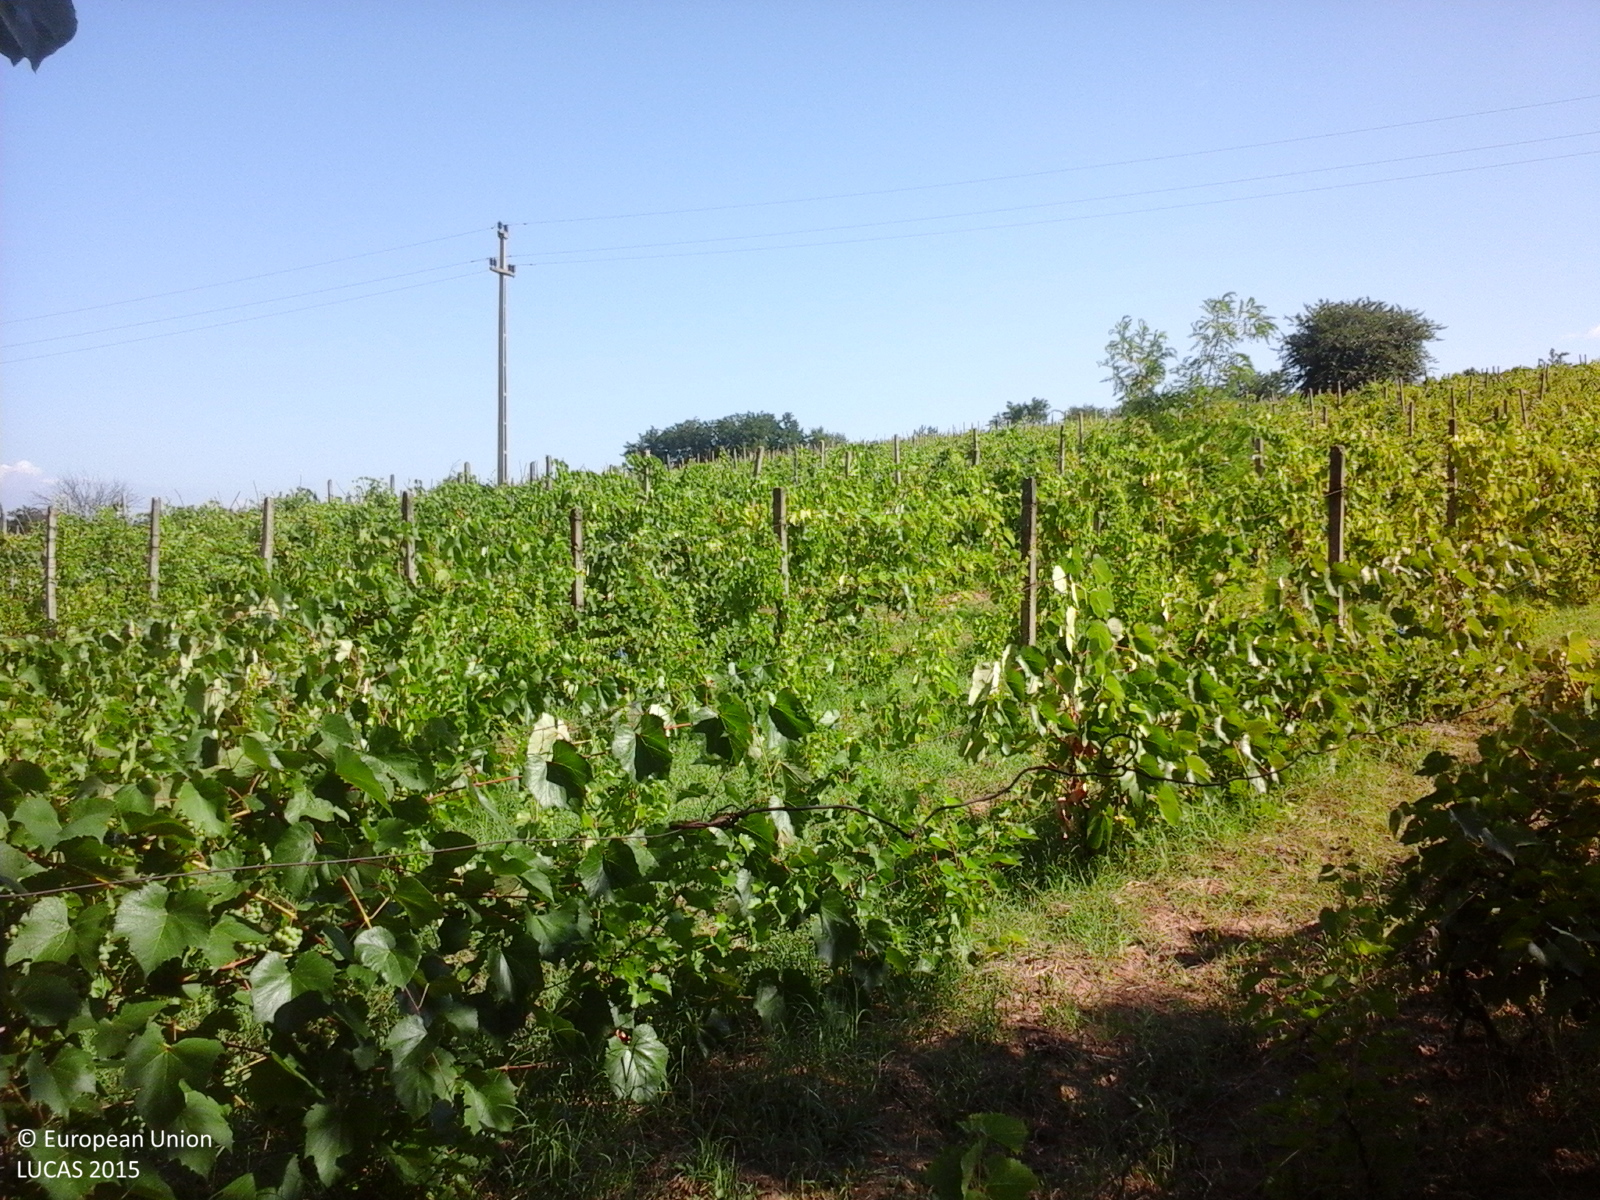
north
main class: Cropland
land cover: Vineyards
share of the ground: > 75 %
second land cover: Other bare soil
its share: > 75 %
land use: Agriculture (excluding fallow land and kitchen gardens)
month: July
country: RO
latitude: 46.3441
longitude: 27.8562
